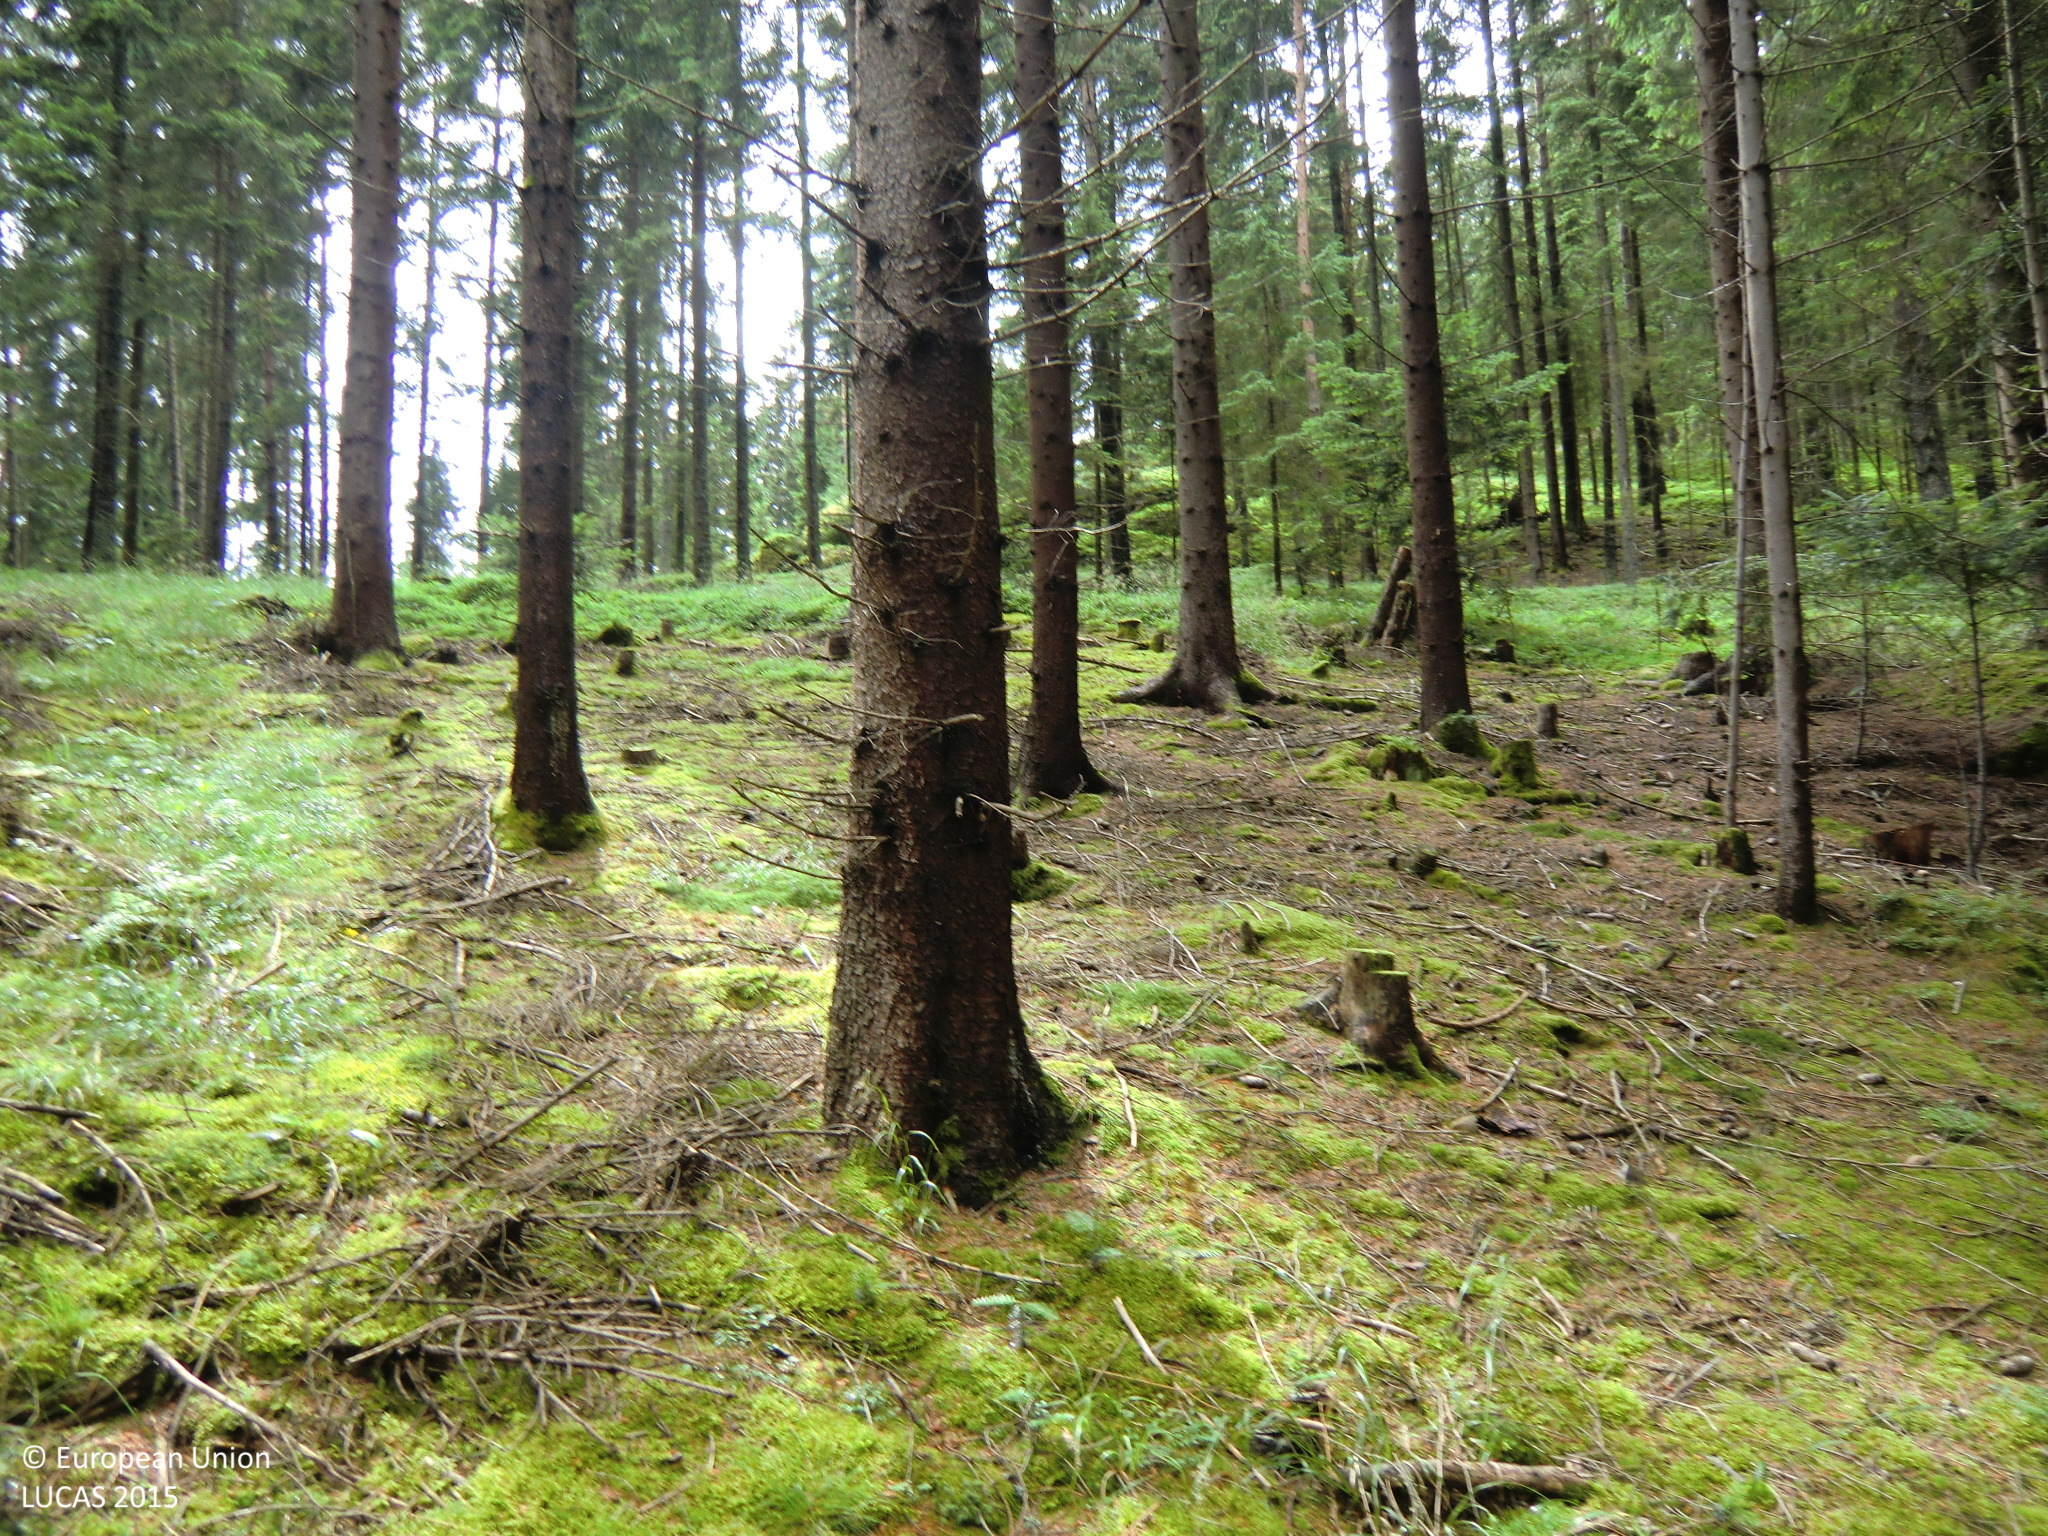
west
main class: Woodland
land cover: Spruce dominated coniferous woodland
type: hemiboreal forest and nemoral coniferous forest and mixed broadleaved-coniferous forest
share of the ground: > 75 %
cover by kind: coniferous forest trees 75 %, lichens and mosses 15 %, herbaceous plants 10 %
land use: Forestry
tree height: > 5 m
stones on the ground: 10 - 25 %
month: June
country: AT
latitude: 48.4302
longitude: 14.6907
